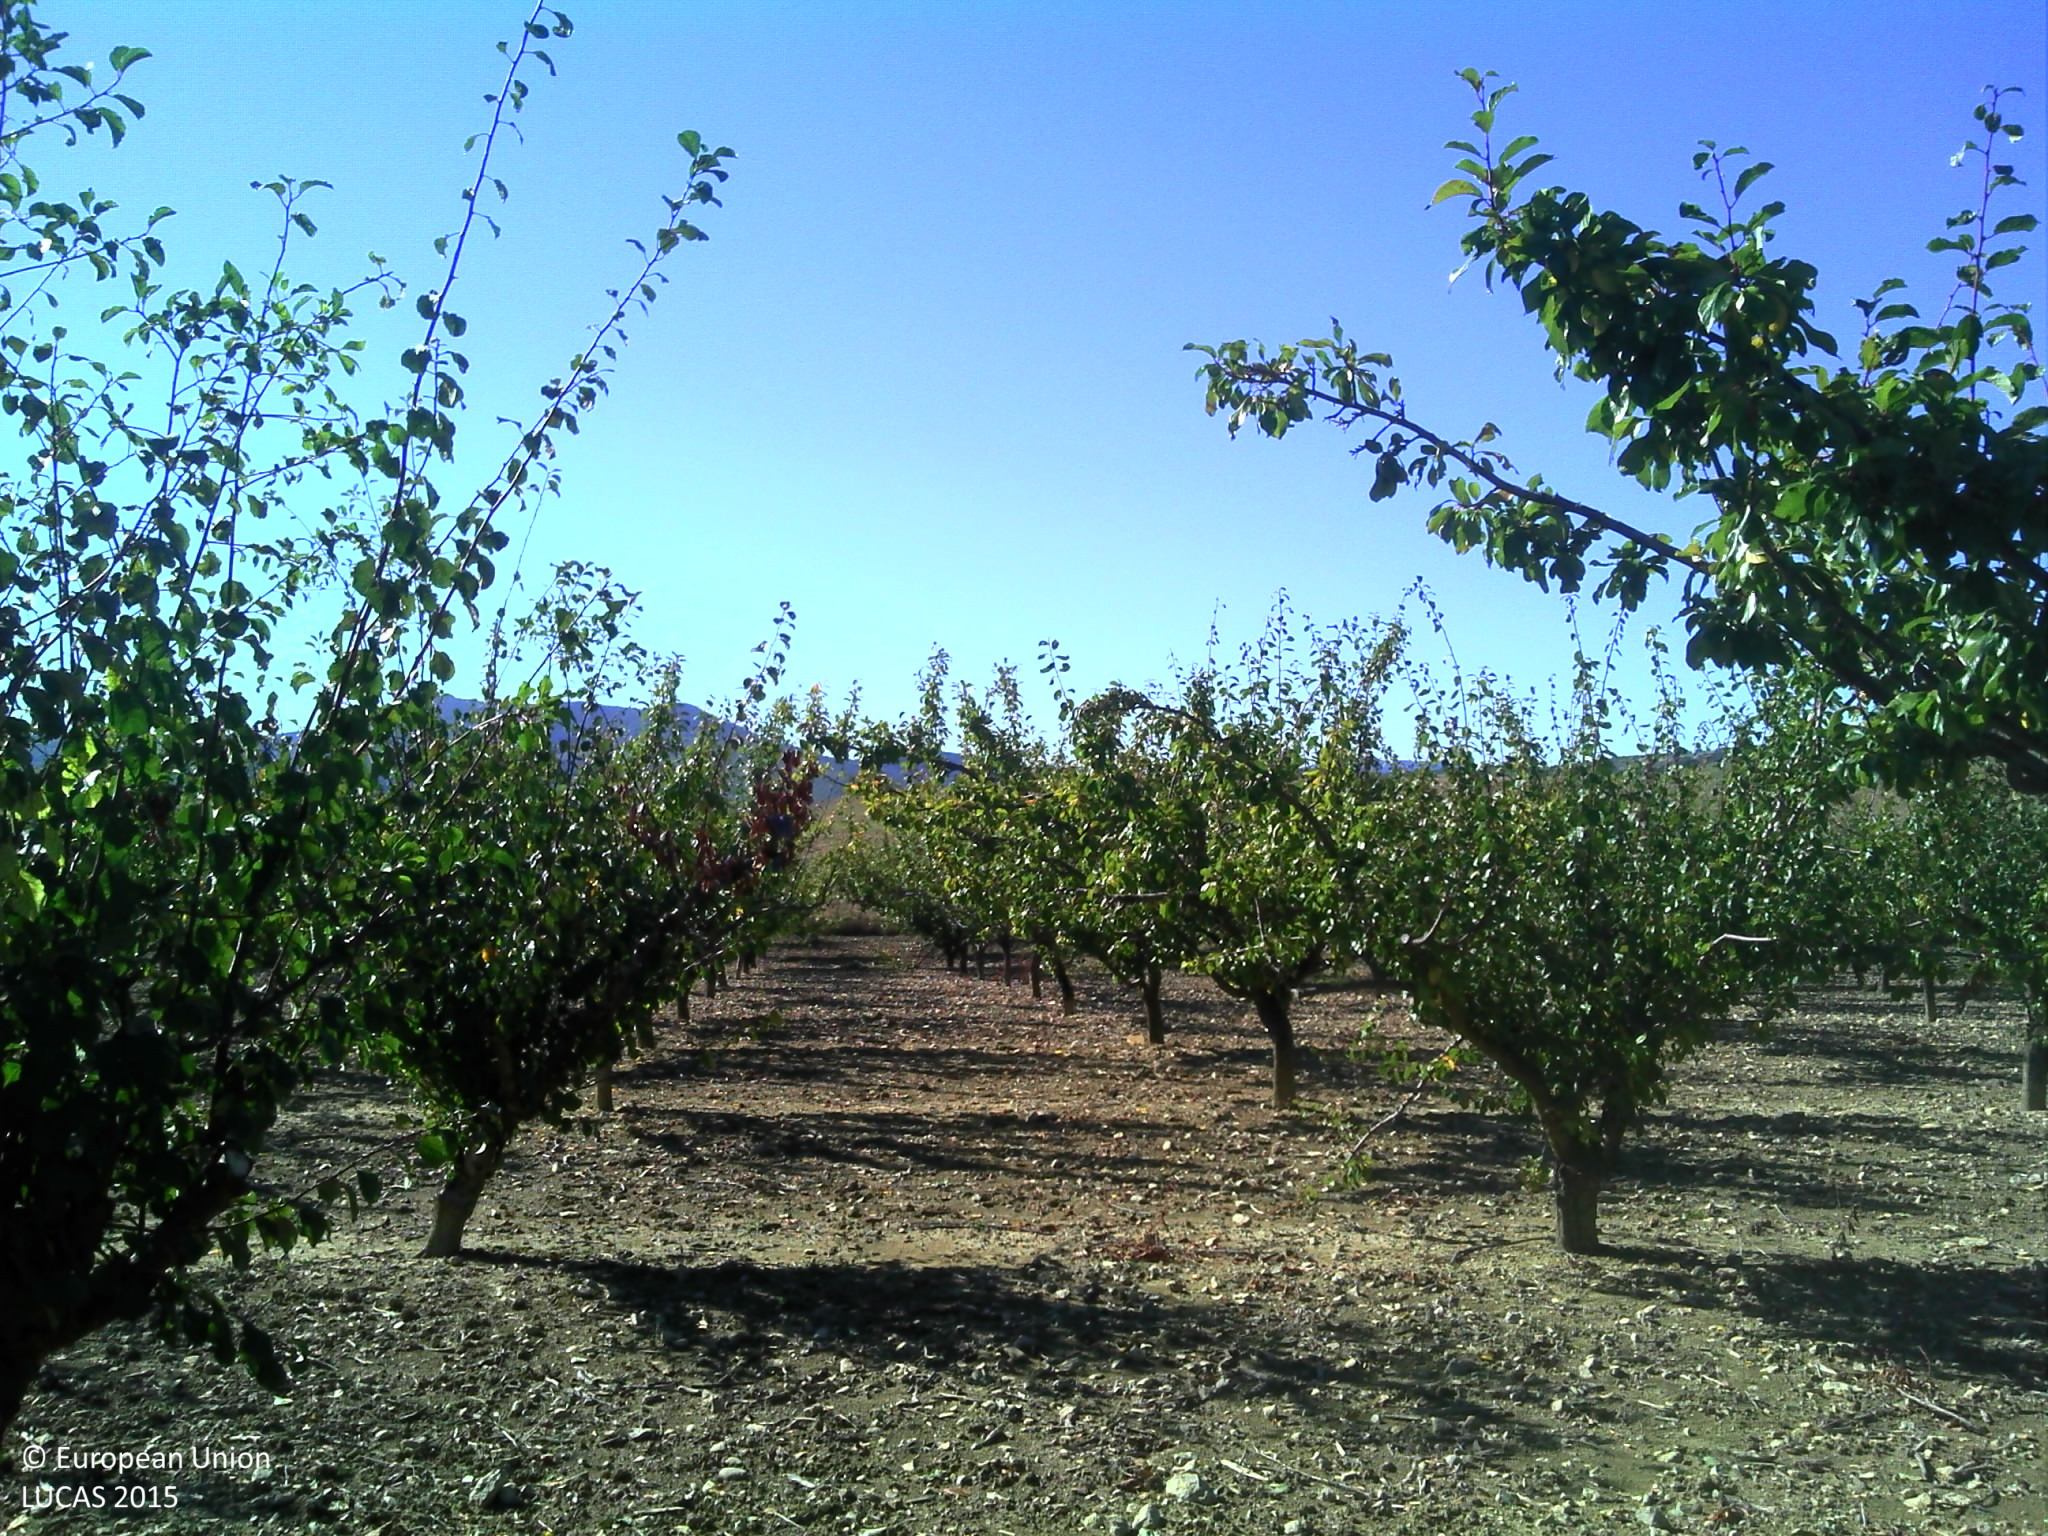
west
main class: Cropland
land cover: Other fruit trees and berries
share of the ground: > 75 %
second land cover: Other bare soil
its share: > 75 %
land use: Agriculture (excluding fallow land and kitchen gardens)
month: September
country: FR
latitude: 44.3357
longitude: 5.3294
